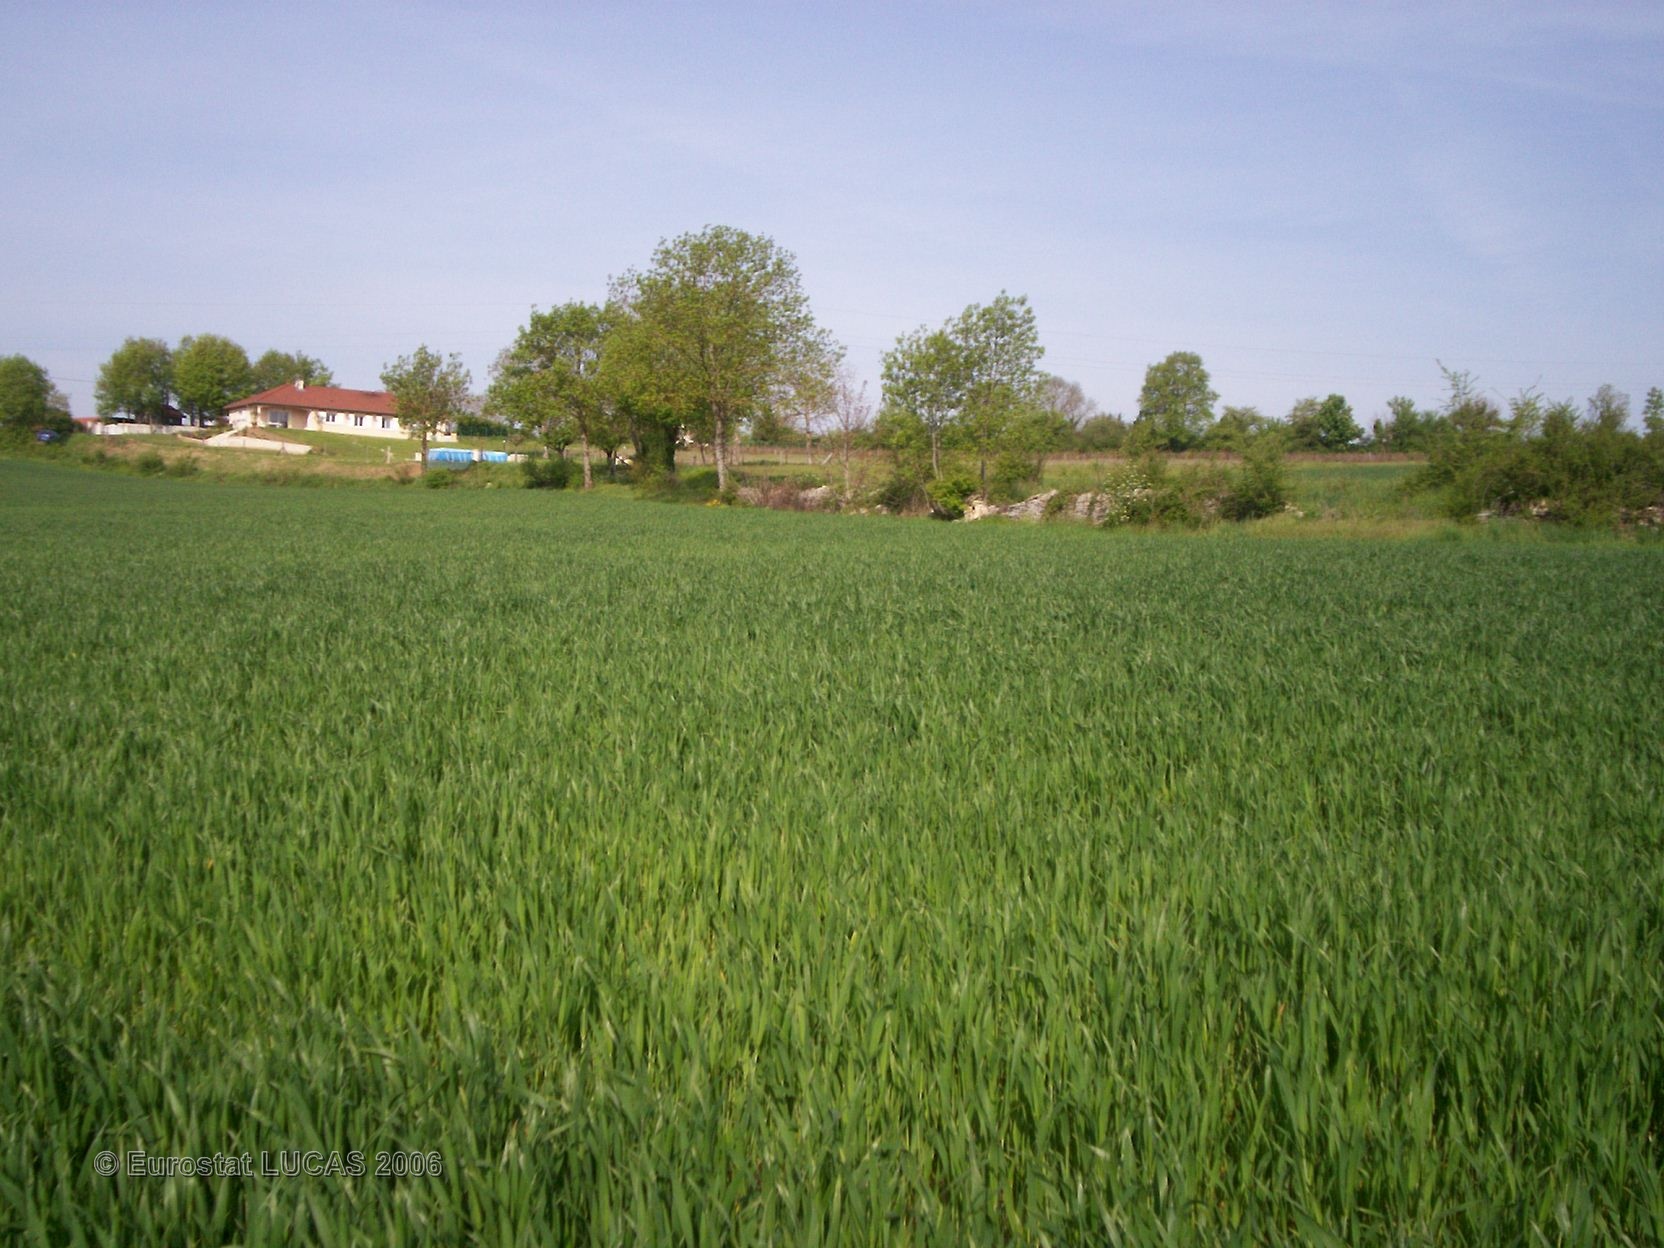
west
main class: Cropland
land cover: Common wheat
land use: Agriculture (excluding fallow land and kitchen gardens)
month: May
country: FR
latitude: 45.7837
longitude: 5.4121
